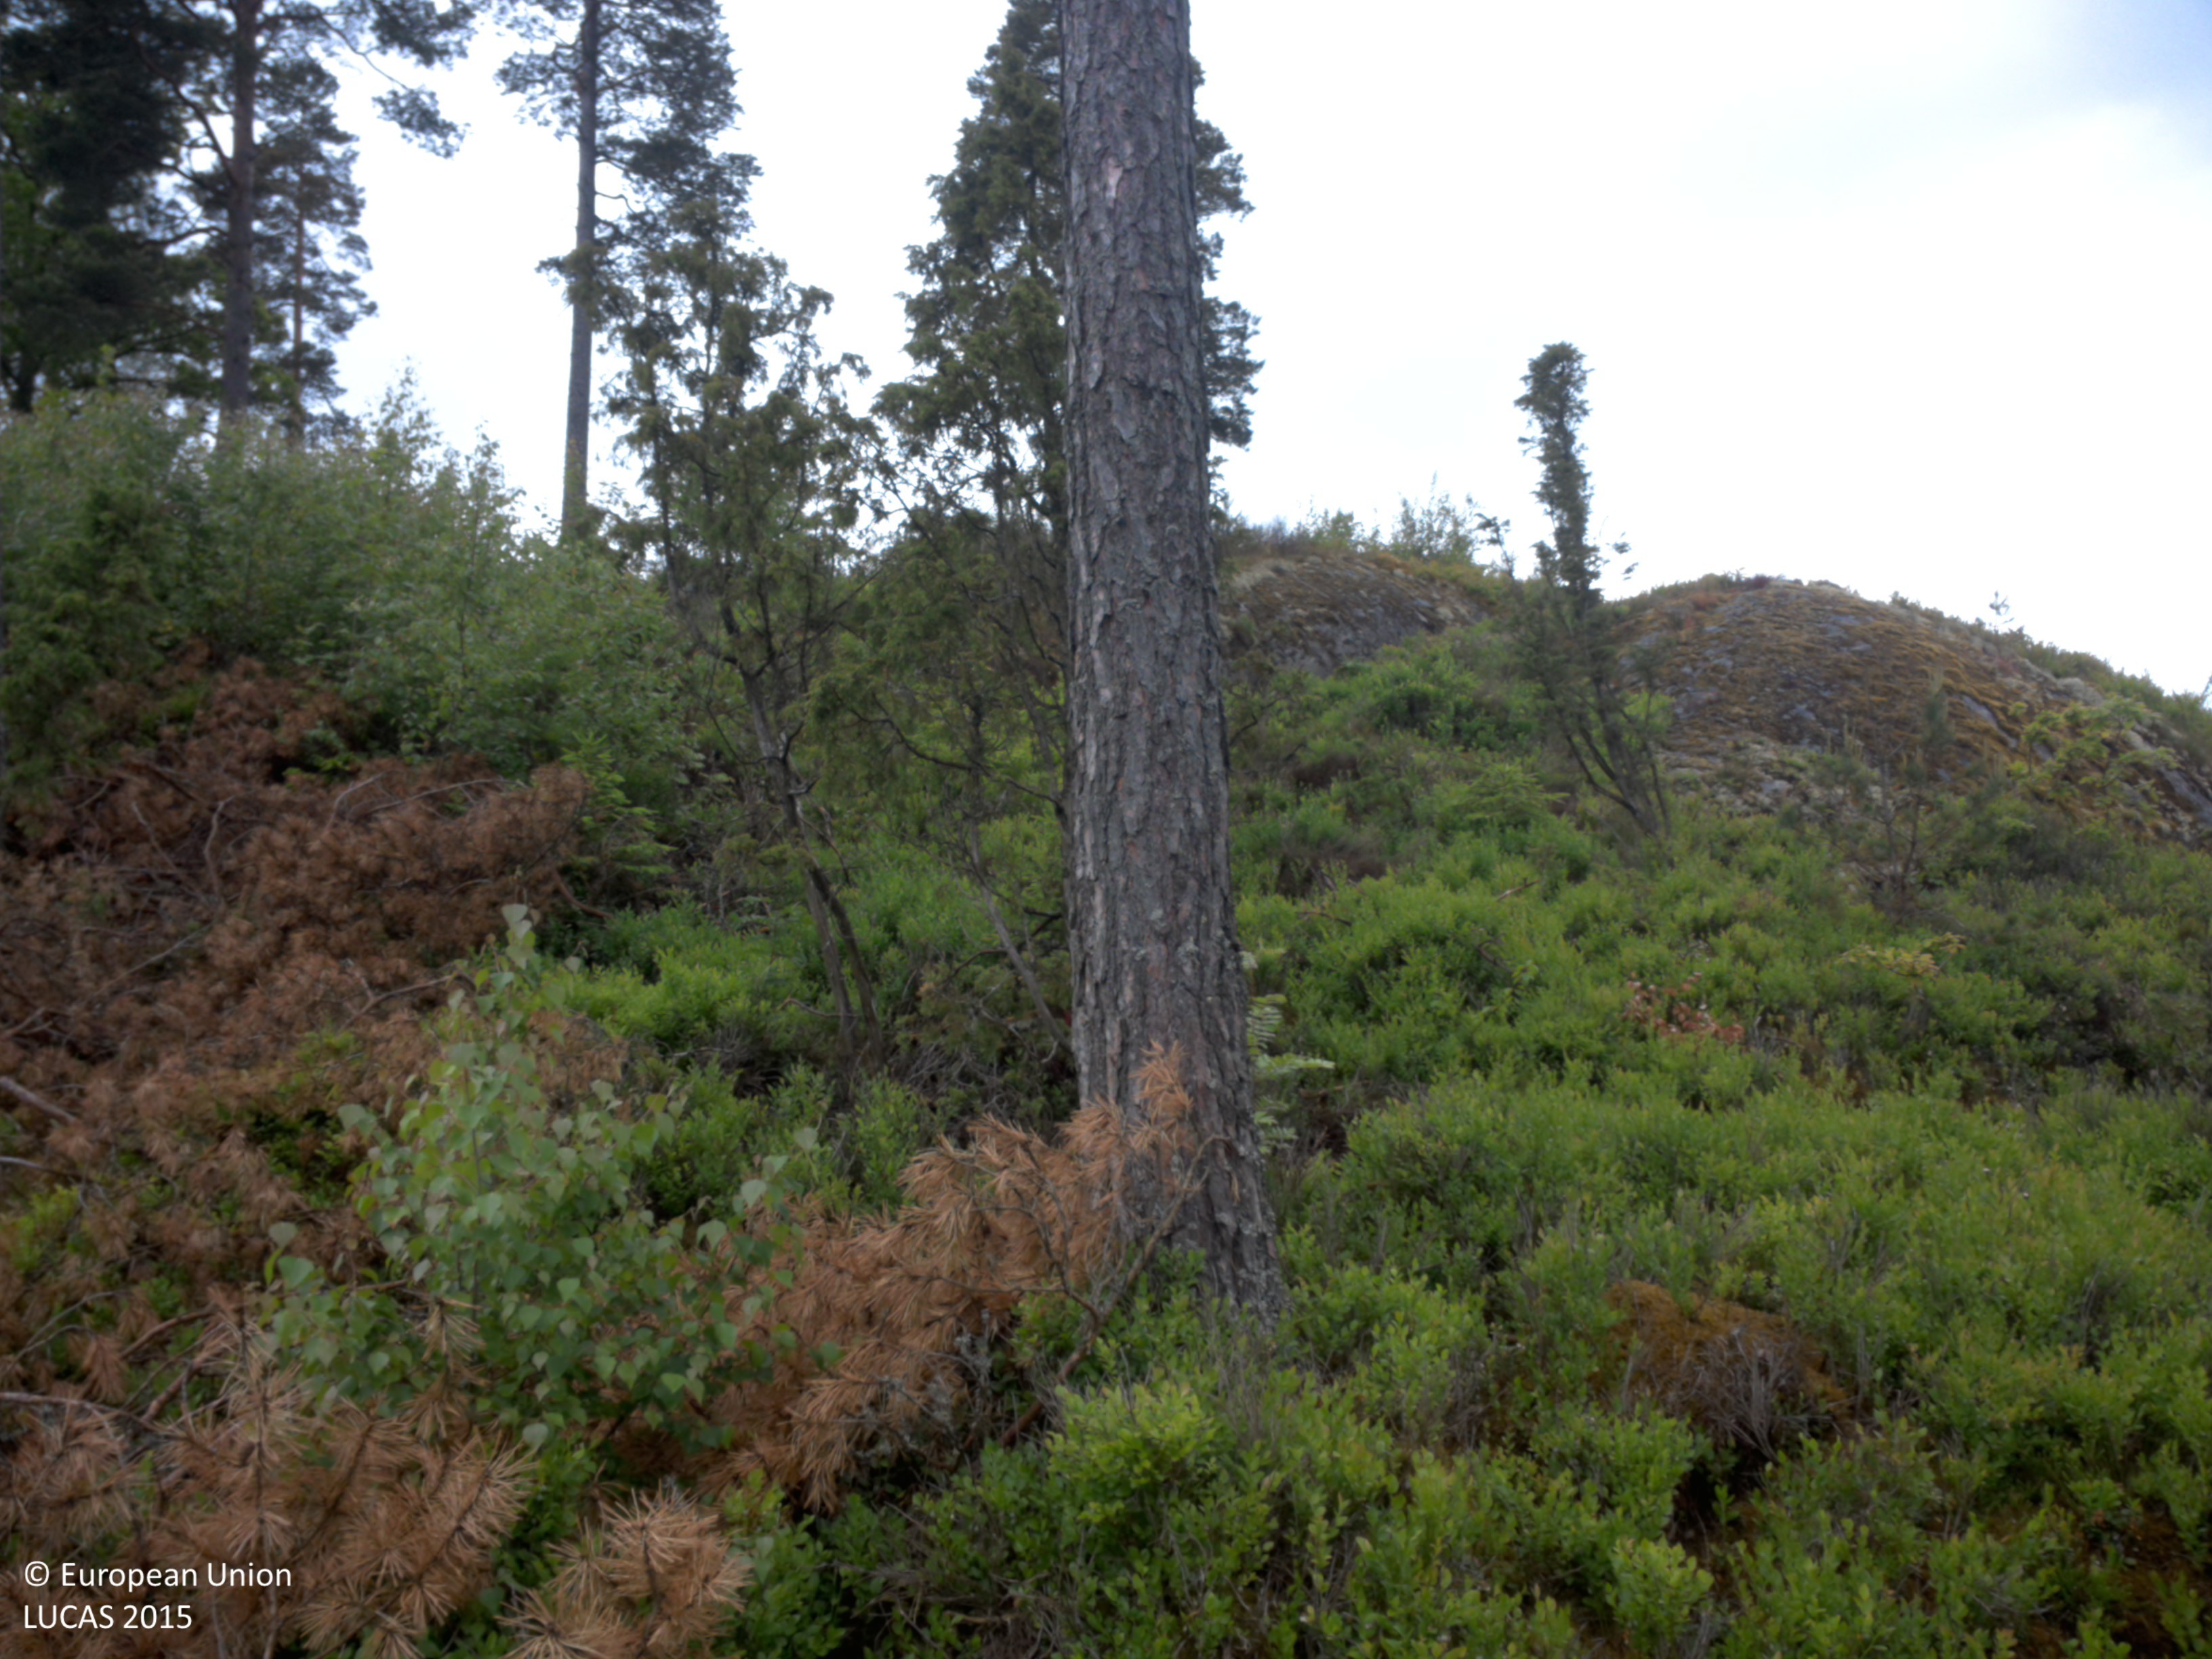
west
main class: Woodland
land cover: Pine dominated coniferous woodland
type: boreal forest
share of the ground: < 10 %
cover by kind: shrubs 80 %, coniferous forest trees 10 %, herbaceous plants 5 %, lichens and mosses 5 %
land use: Amenities, museums, leisure
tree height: > 5 m
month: June
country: SE
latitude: 58.4247
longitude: 11.6916
